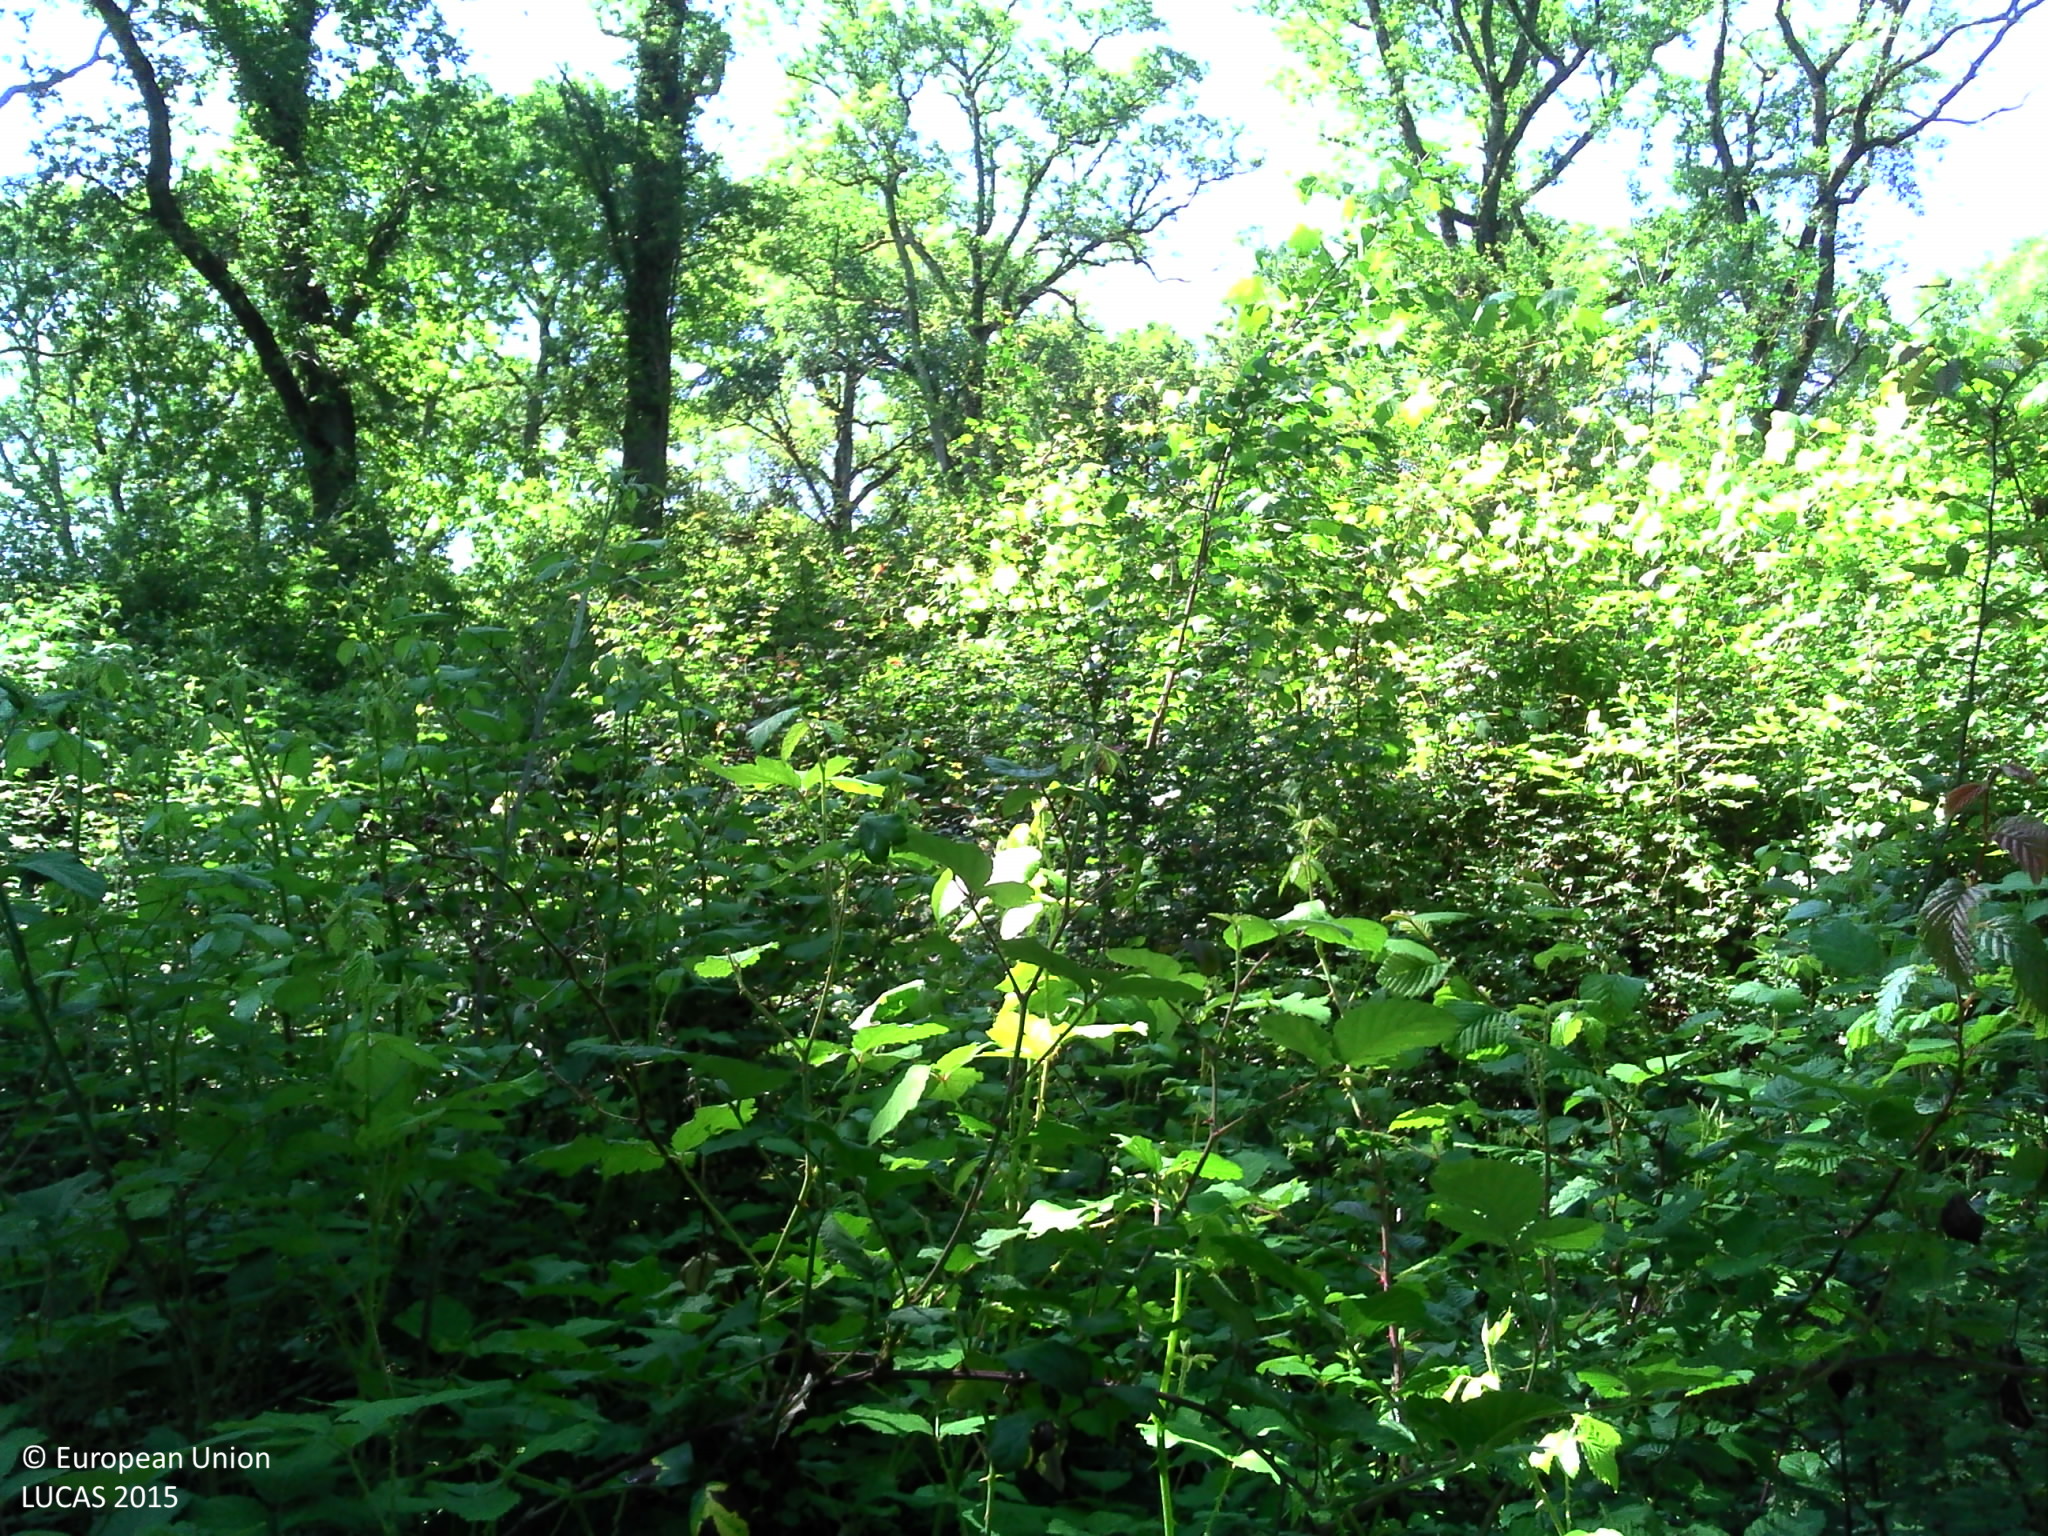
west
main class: Woodland
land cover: Broadleaved woodland
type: acidophilous oak and oak-birch forest
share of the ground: > 75 %
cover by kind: broadleaved forest trees 90 %, shrubs 10 %
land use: Forestry
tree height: > 5 m
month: June
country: FR
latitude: 47.0284
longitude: 2.7708
